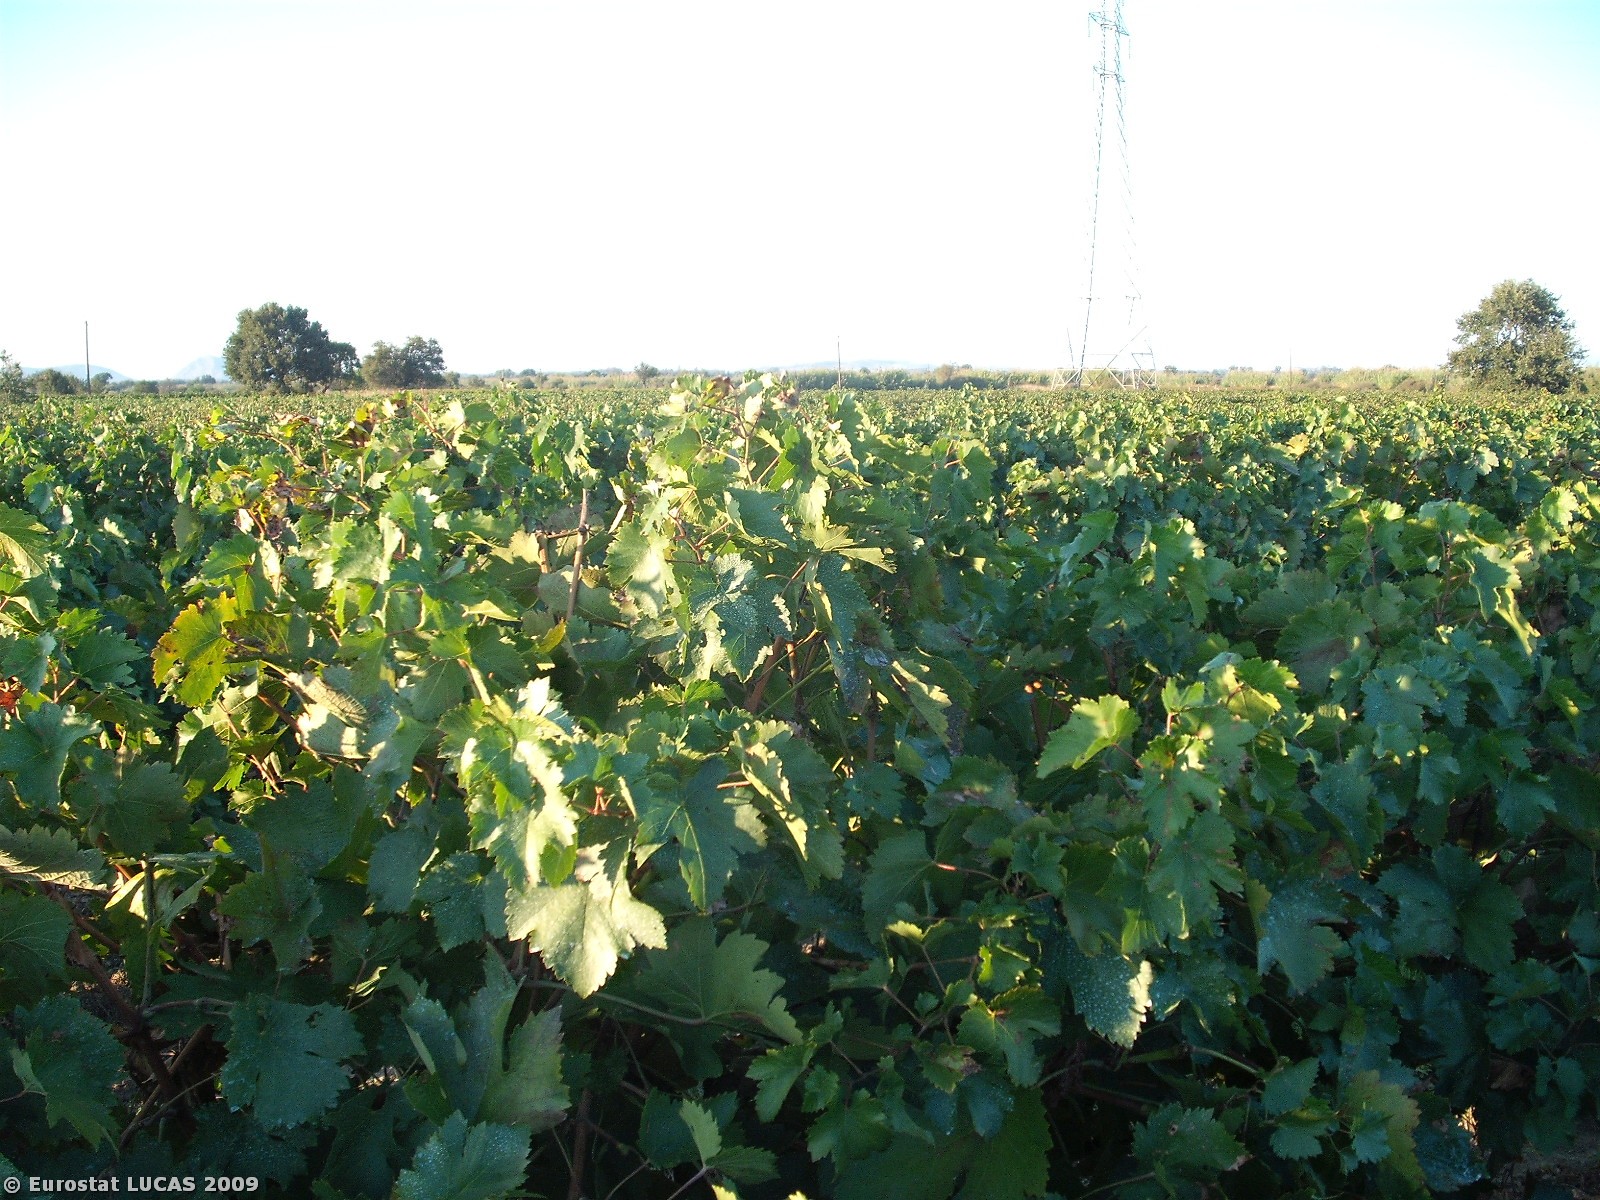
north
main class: Cropland
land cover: Vineyards
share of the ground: 25 - 50 %
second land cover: Grassland with sparse tree/shrub cover
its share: 50 - 75 %
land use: Agriculture (excluding fallow land and kitchen gardens)
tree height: < 5 m
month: October
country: GR
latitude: 38.0788
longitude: 21.4437
